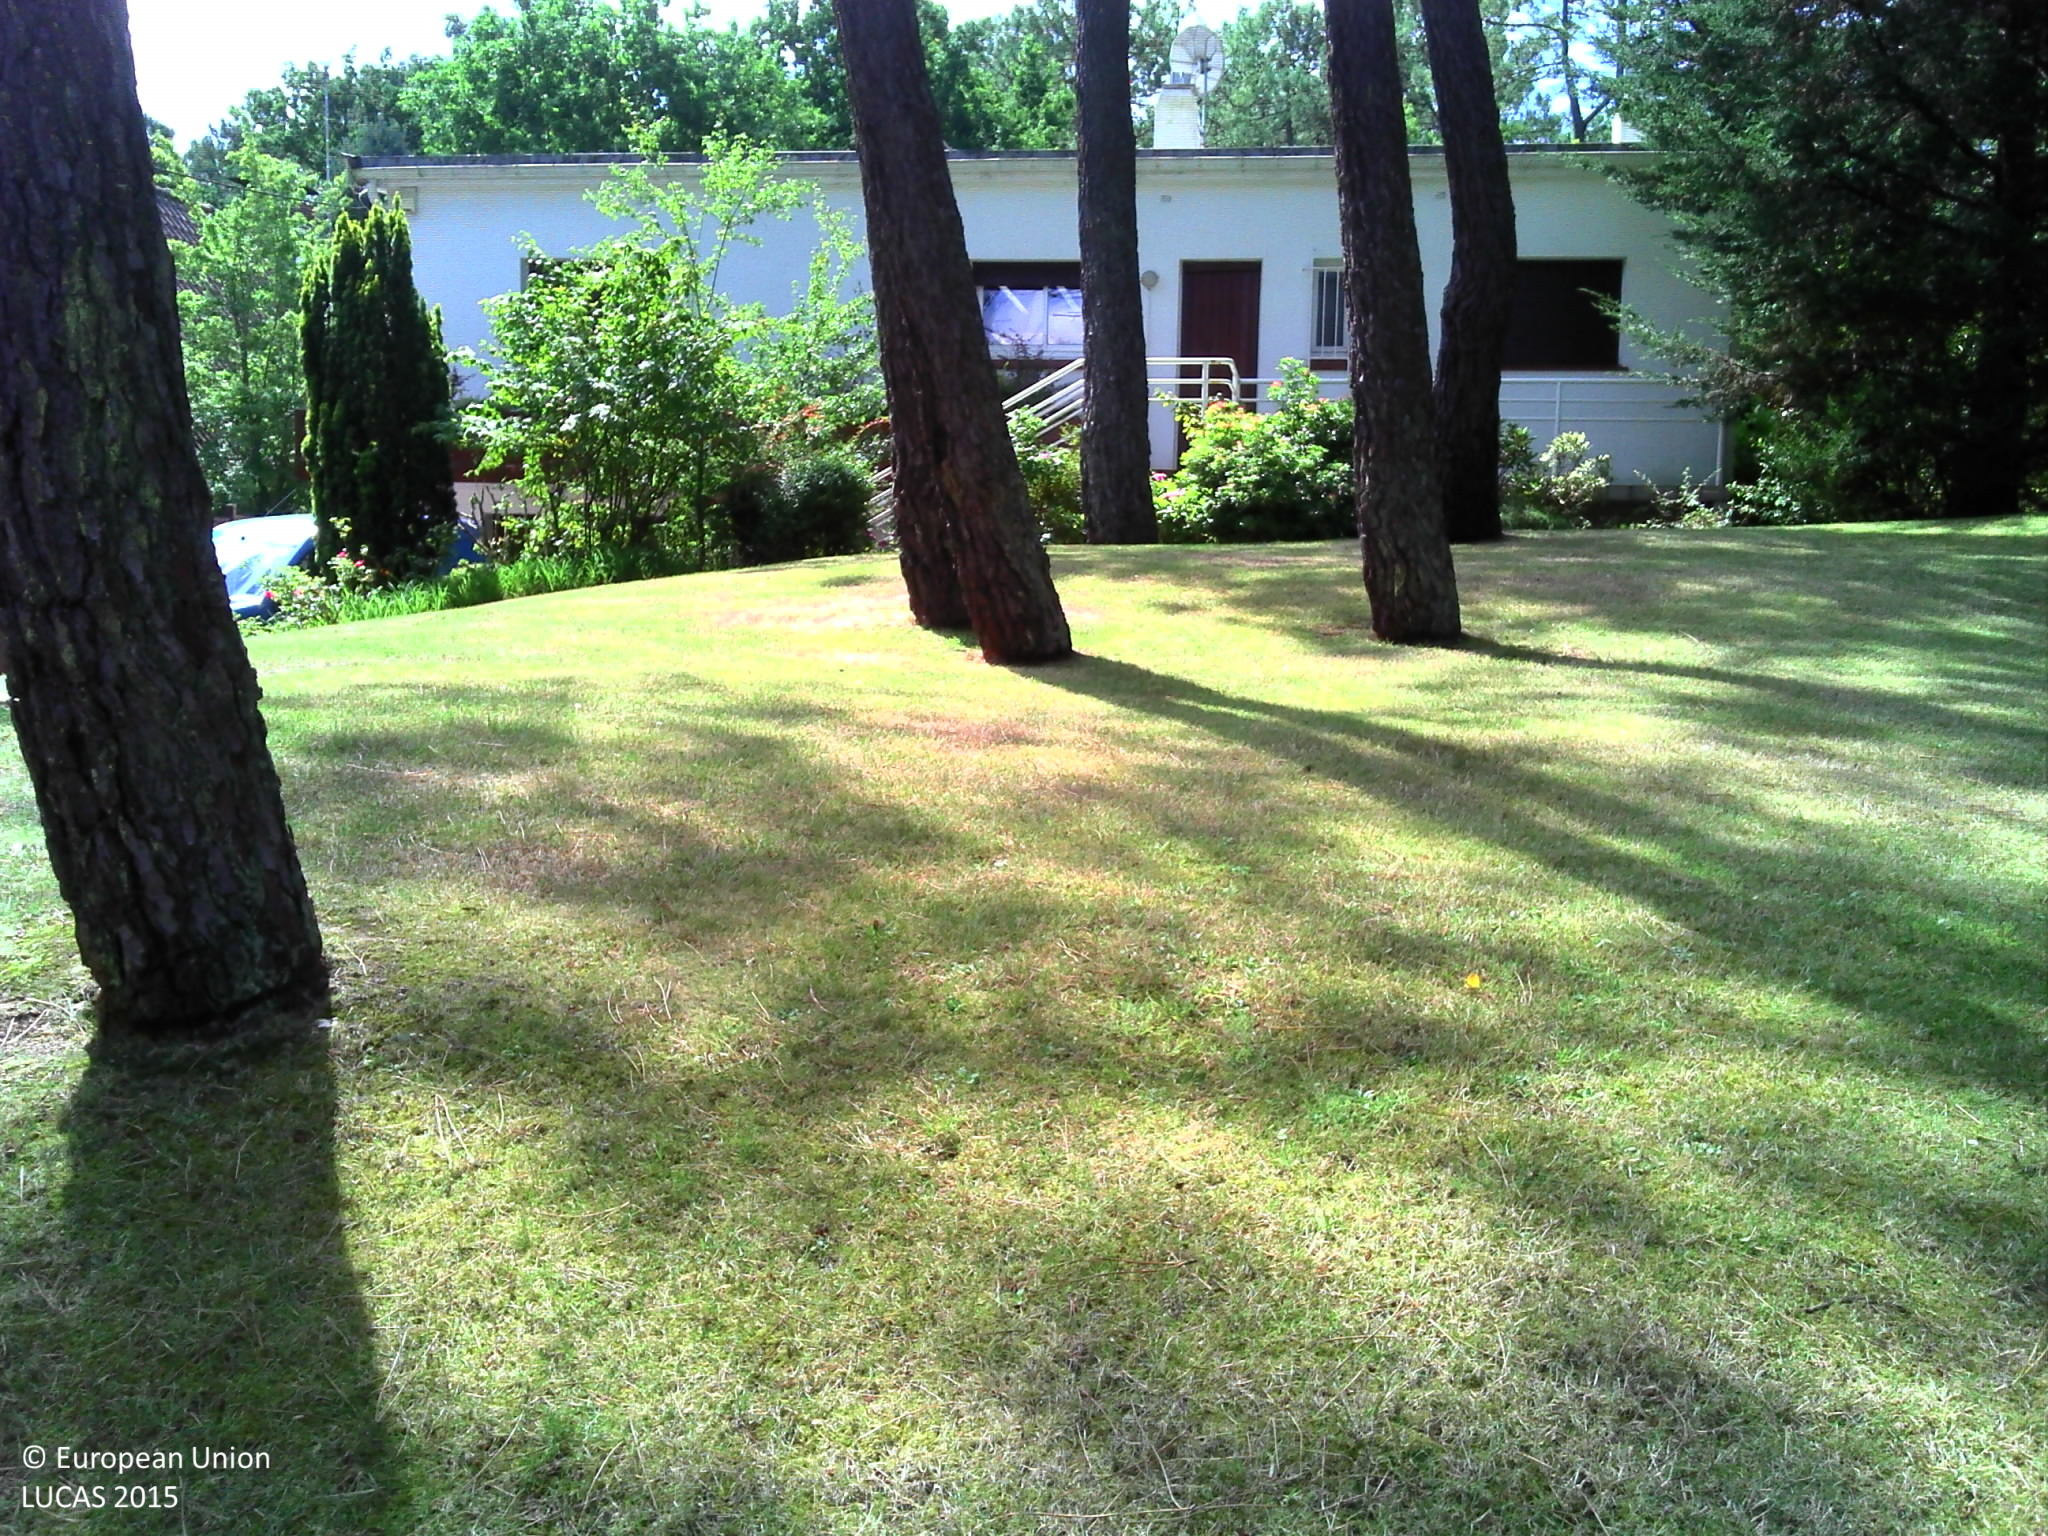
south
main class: Woodland
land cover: Pine dominated coniferous woodland
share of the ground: 50 - 75 %
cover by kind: herbaceous plants 60 %, coniferous forest trees 40 %
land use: Residential
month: July
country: FR
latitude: 50.5081
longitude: 1.6199
